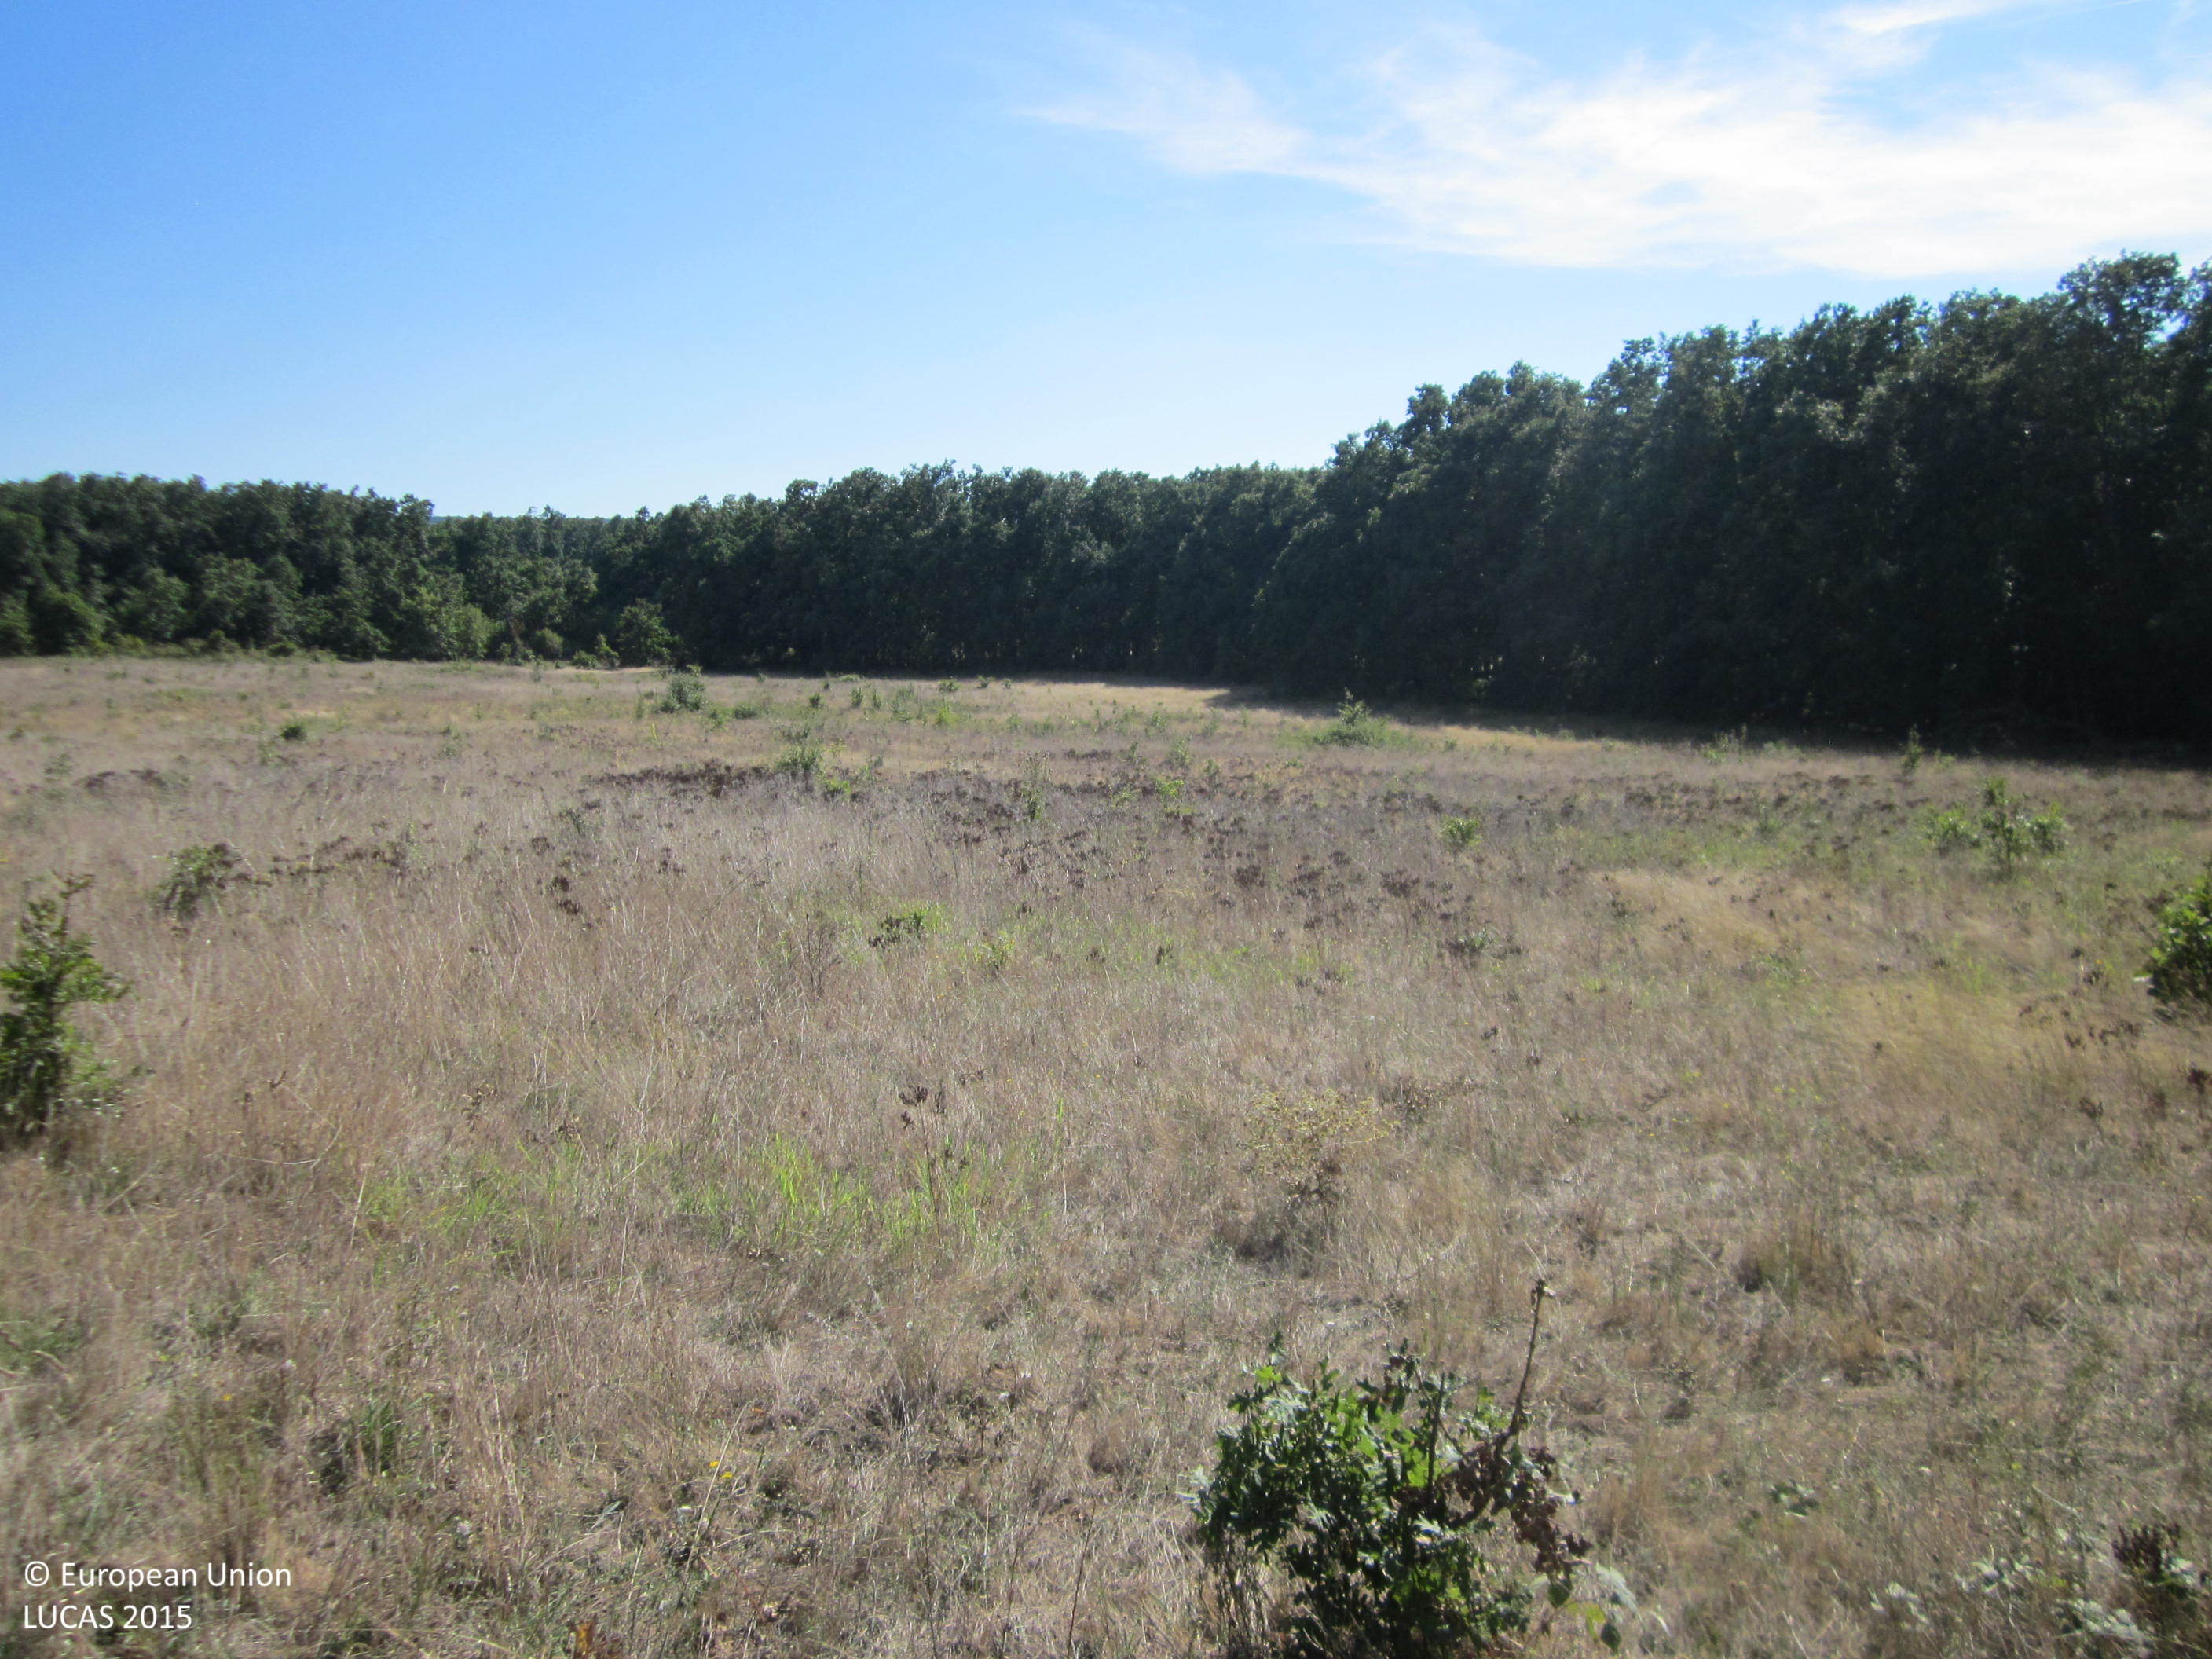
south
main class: Grassland
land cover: Grassland with sparse tree/shrub cover
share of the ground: > 75 %
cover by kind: herbaceous plants 85 %, shrubs 10 %, broadleaved forest trees 5 %
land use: Agriculture (excluding fallow land and kitchen gardens)
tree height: > 5 m
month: September
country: BG
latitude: 42.1039
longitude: 27.0171
